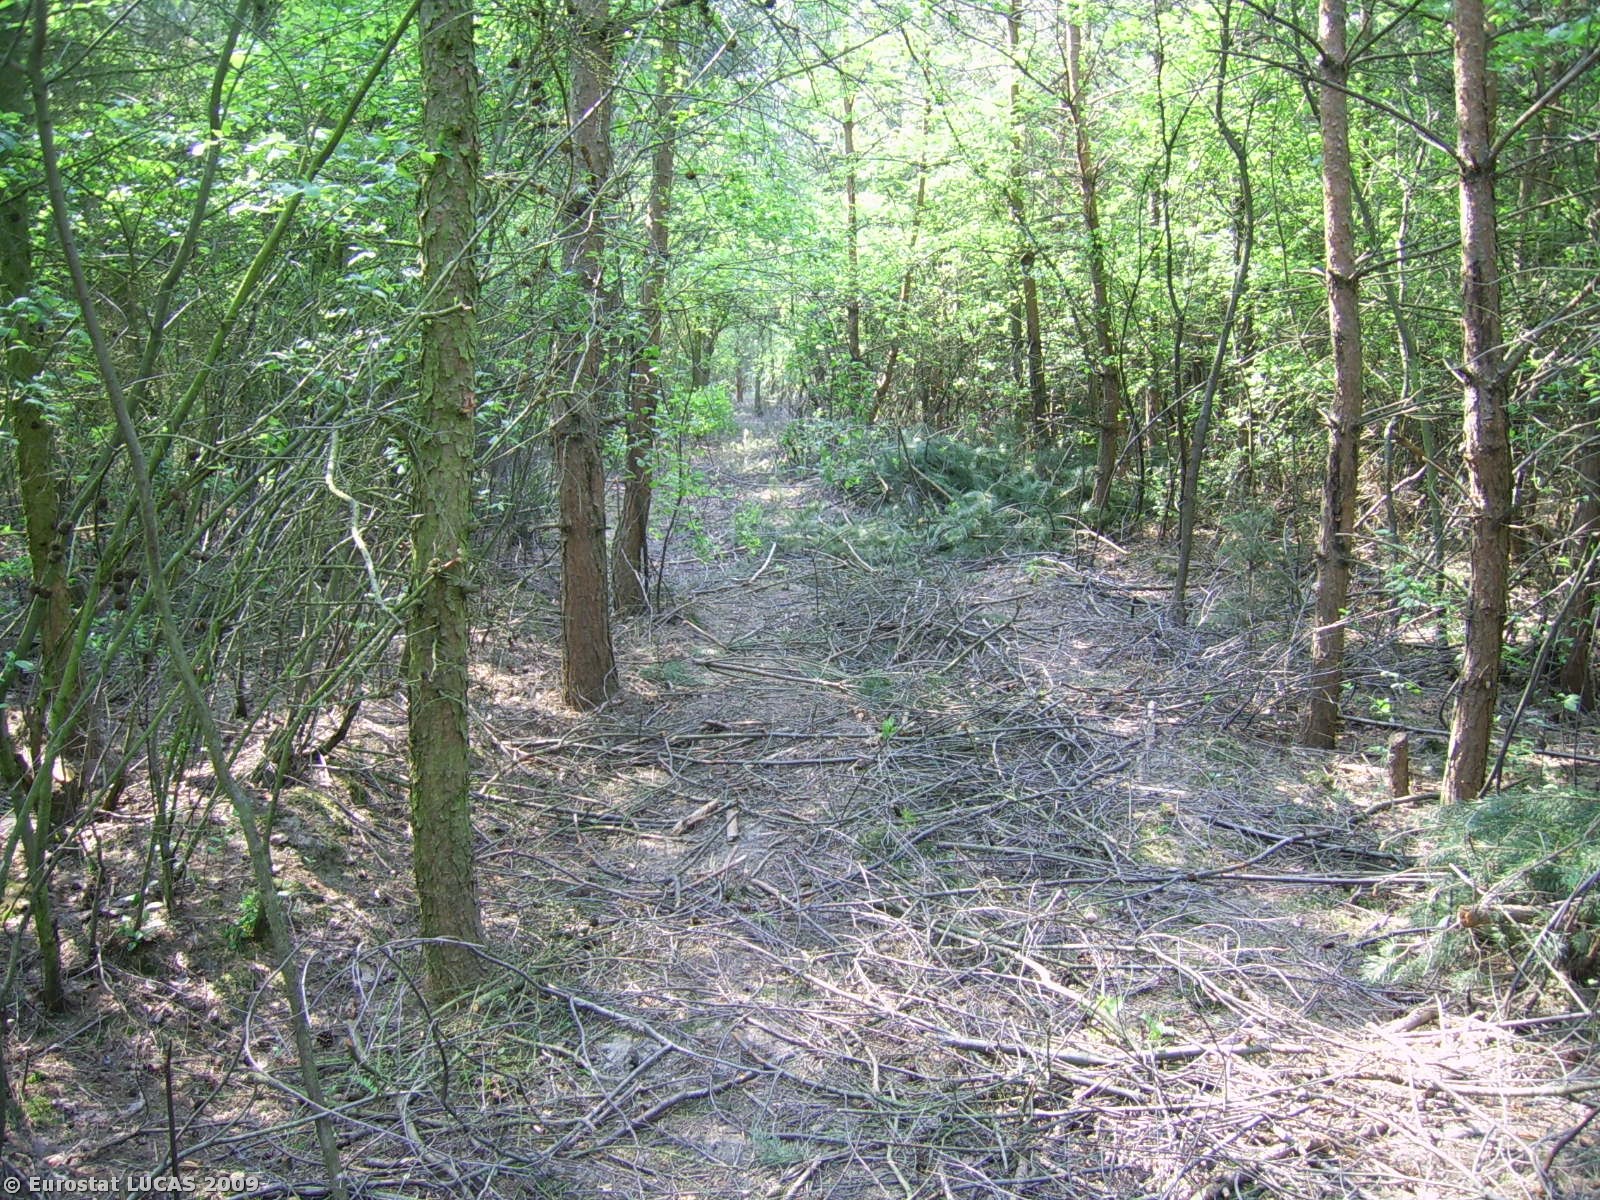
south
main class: Woodland
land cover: Mixed woodland
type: hemiboreal forest and nemoral coniferous forest and mixed broadleaved-coniferous forest
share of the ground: > 75 %
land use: Forestry
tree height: > 5 m
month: April
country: PL
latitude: 52.0500
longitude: 16.9068
